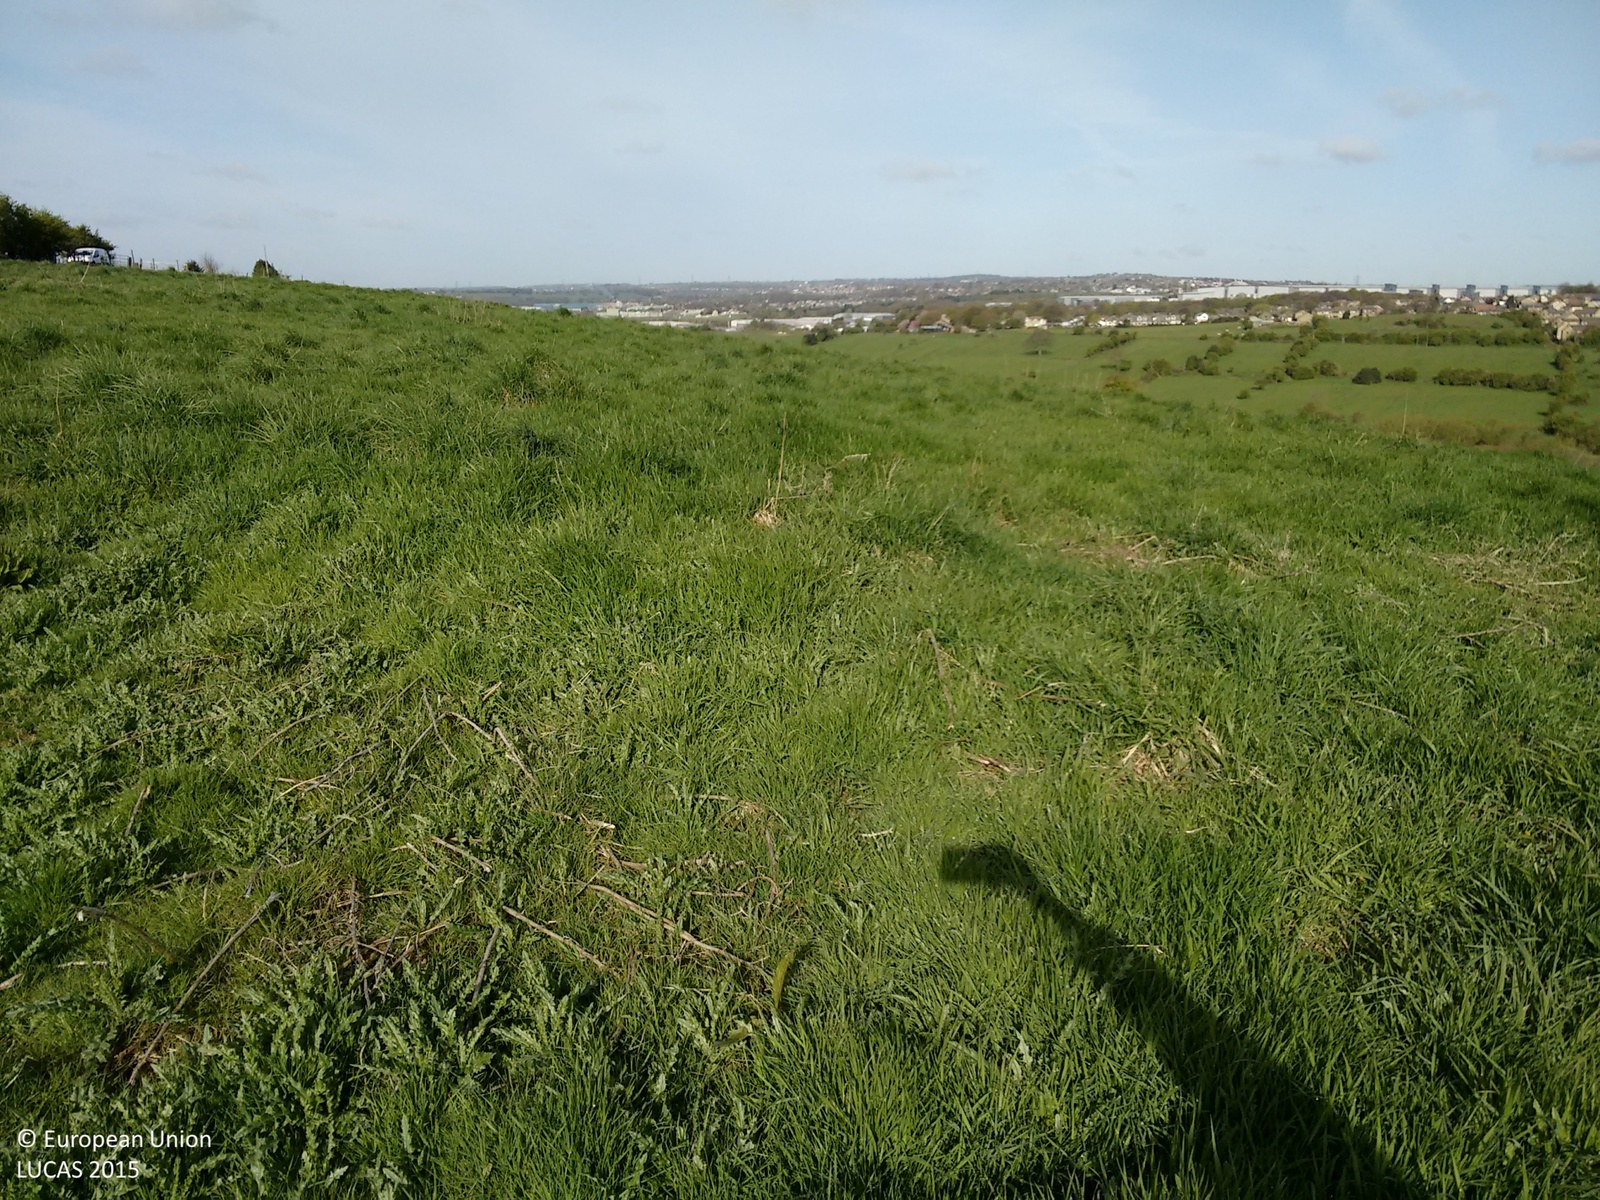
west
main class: Grassland
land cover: Grassland without tree/shrub cover
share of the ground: > 75 %
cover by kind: herbaceous plants 100 %
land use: Agriculture (excluding fallow land and kitchen gardens)
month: May
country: GB
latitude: 53.7578
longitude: -1.7168
